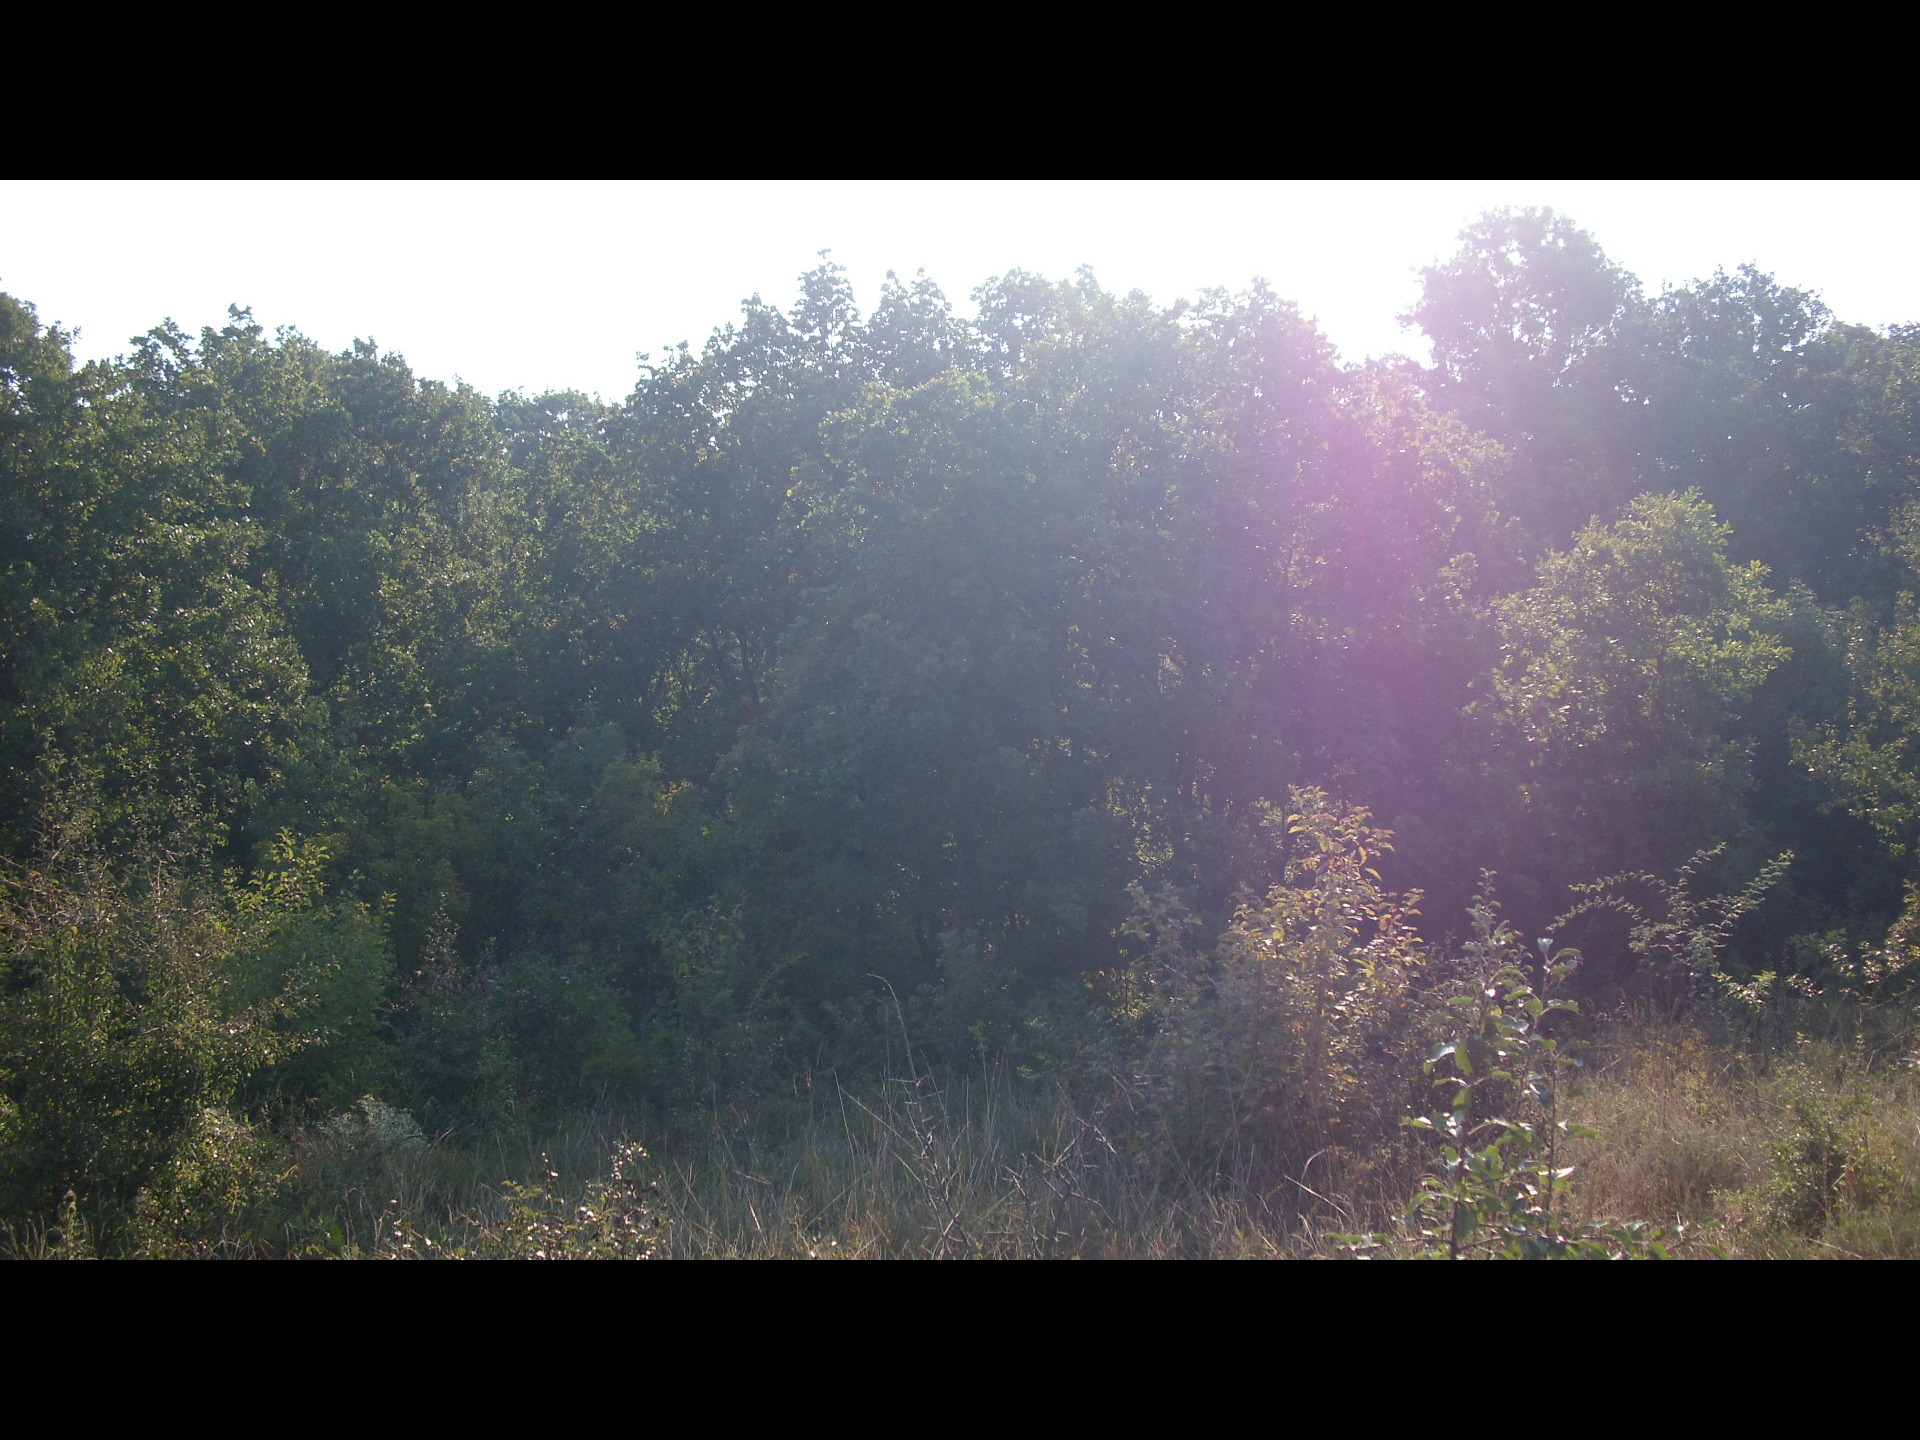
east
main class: Shrubland
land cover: Shrubland with sparse tree cover
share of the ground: 50 - 75 %
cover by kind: shrubs 65 %, herbaceous plants 30 %, broadleaved forest trees 5 %
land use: Agriculture (excluding fallow land and kitchen gardens)
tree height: < 5 m
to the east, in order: Shrubland with sparse tree cover; Broadleaved woodland; Grassland with sparse tree/shrub cover; Spontaneously vegetated surfaces; Sunflower; Grassland with sparse tree/shrub cover; Tracks; Grassland with sparse tree/shrub cover; Maize
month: September
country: BG
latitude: 44.0820
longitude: 22.6628
